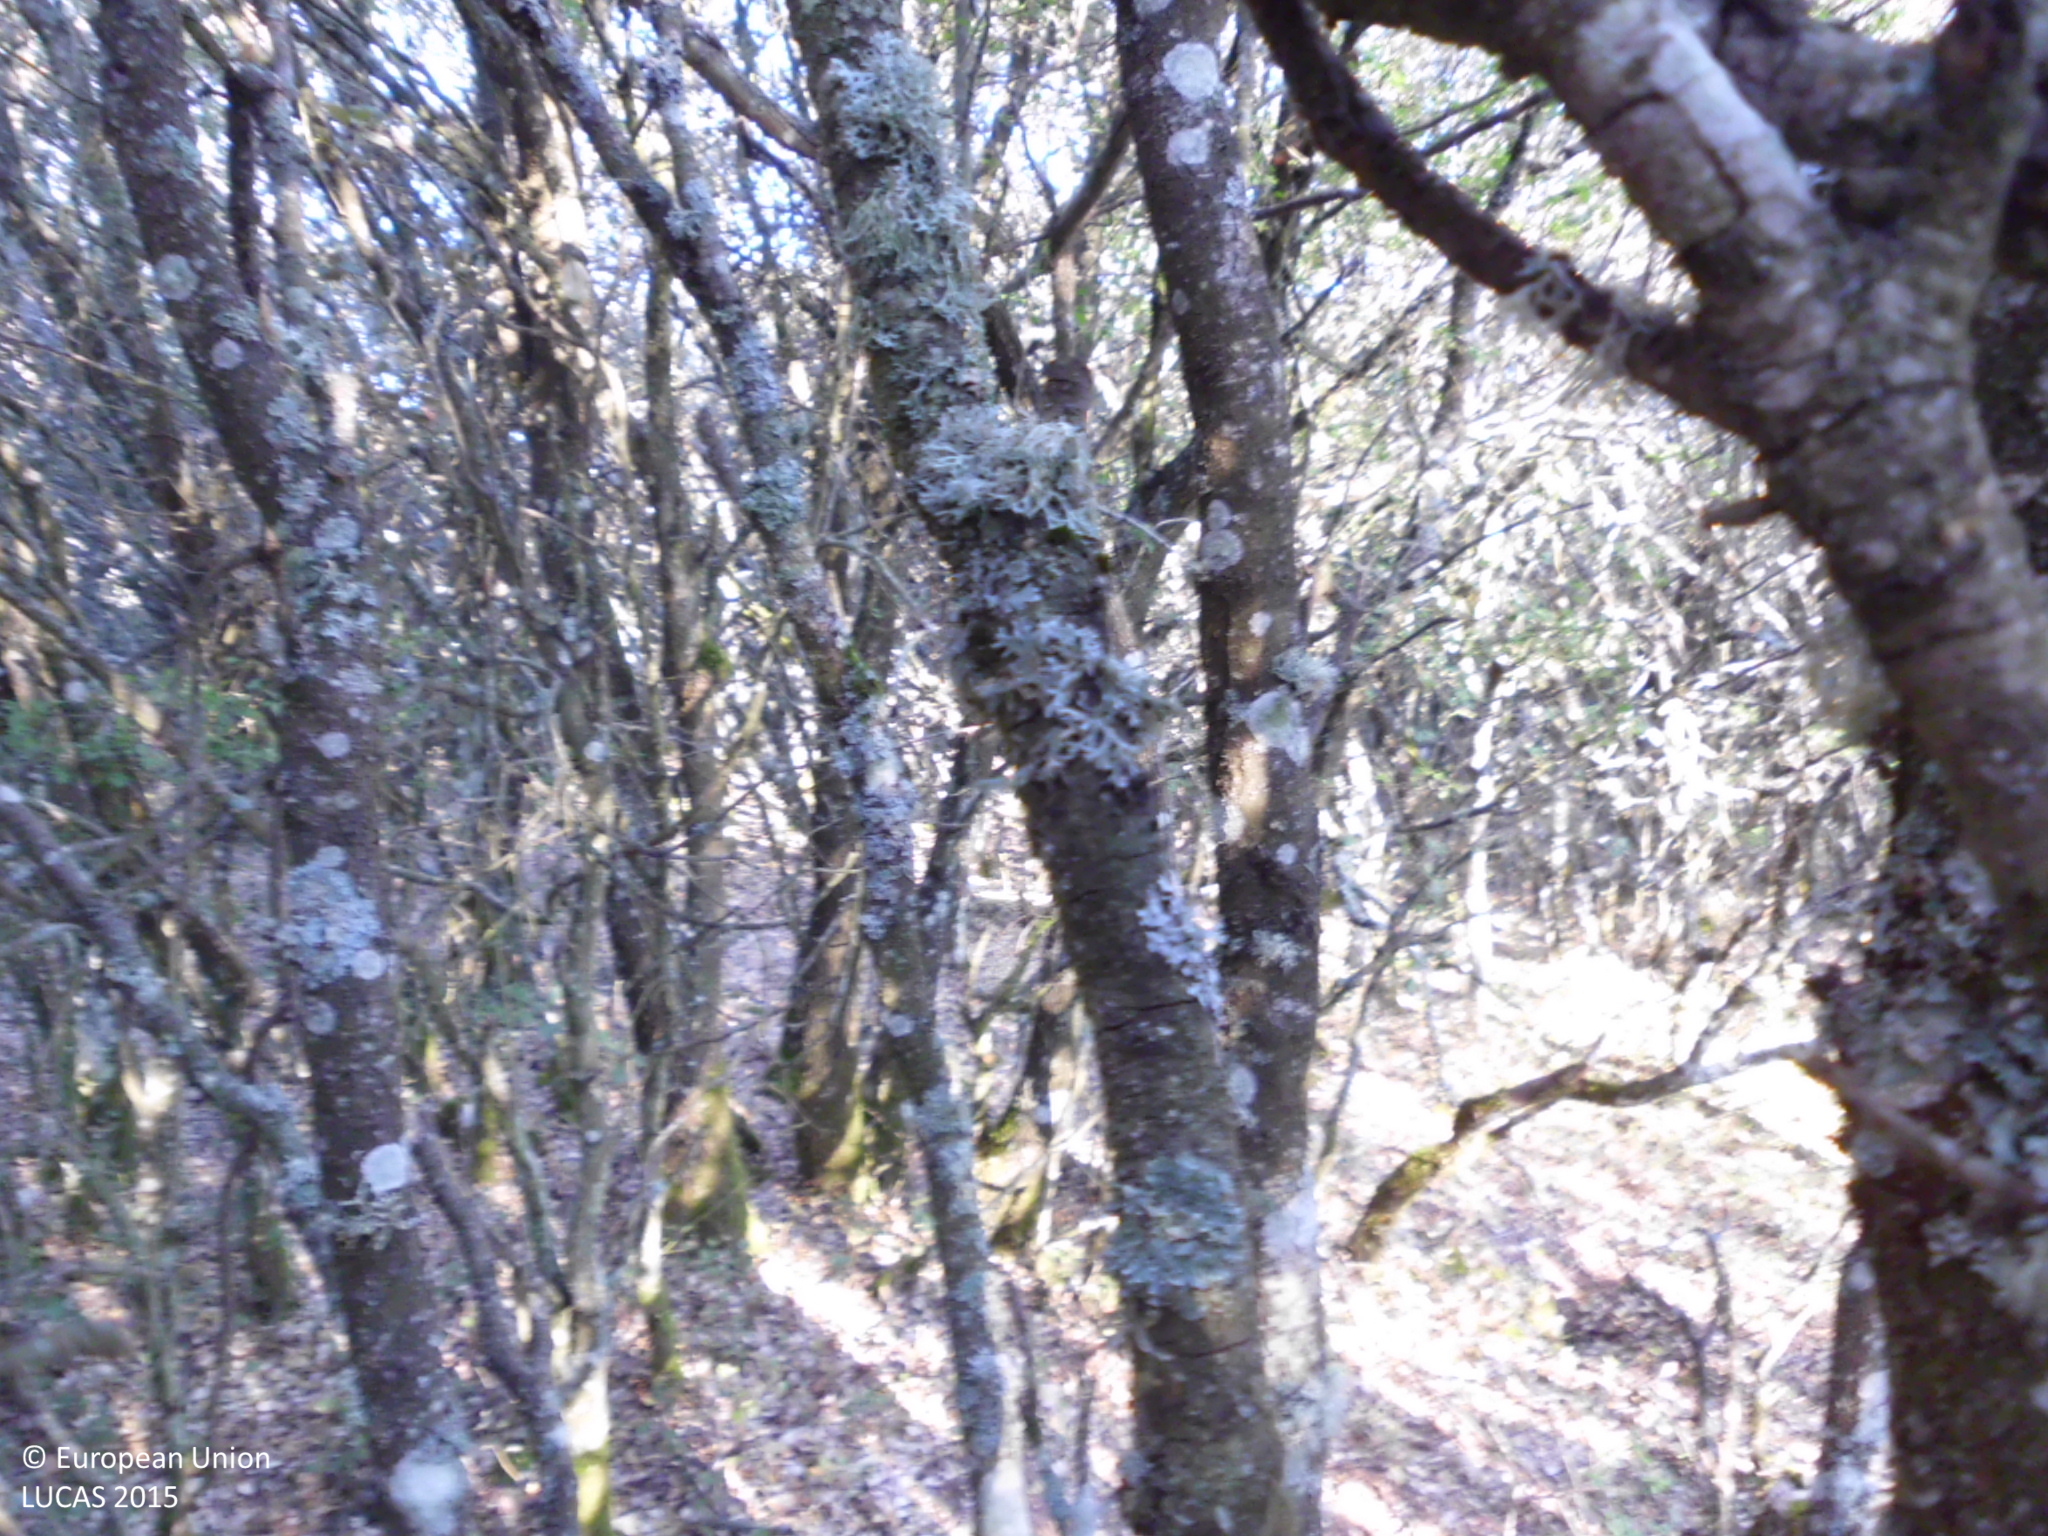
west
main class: Woodland
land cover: Broadleaved woodland
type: acidophilous oak and oak-birch forest
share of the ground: > 75 %
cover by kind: broadleaved forest trees 80 %, herbaceous plants 15 %, shrubs 5 %
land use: Semi-natural and natural areas not in use
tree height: < 5 m
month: June
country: ES
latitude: 42.3758
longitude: -3.9706
